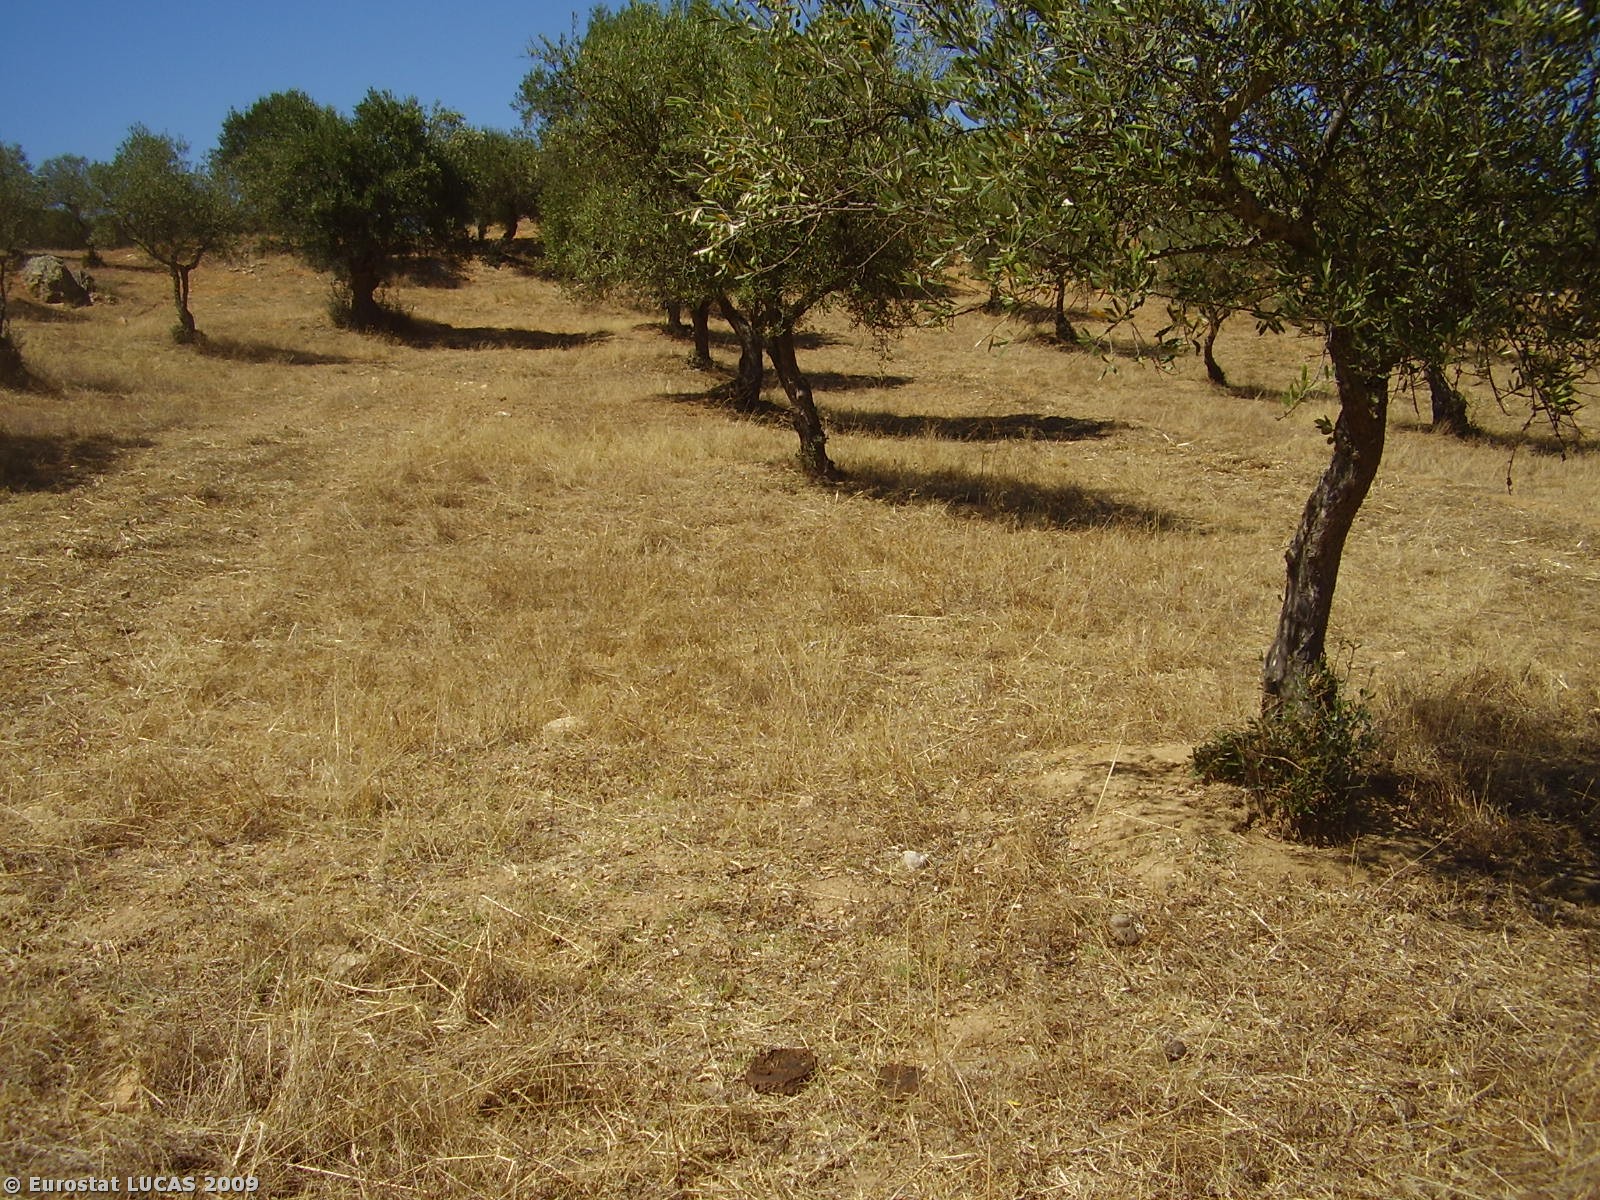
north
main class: Cropland
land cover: Olive groves
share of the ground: 25 - 50 %
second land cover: Spontaneously vegetated surfaces
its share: 25 - 50 %
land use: Agriculture (excluding fallow land and kitchen gardens)
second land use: Fallow land
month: July
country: PT
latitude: 37.8968
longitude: -7.5423
